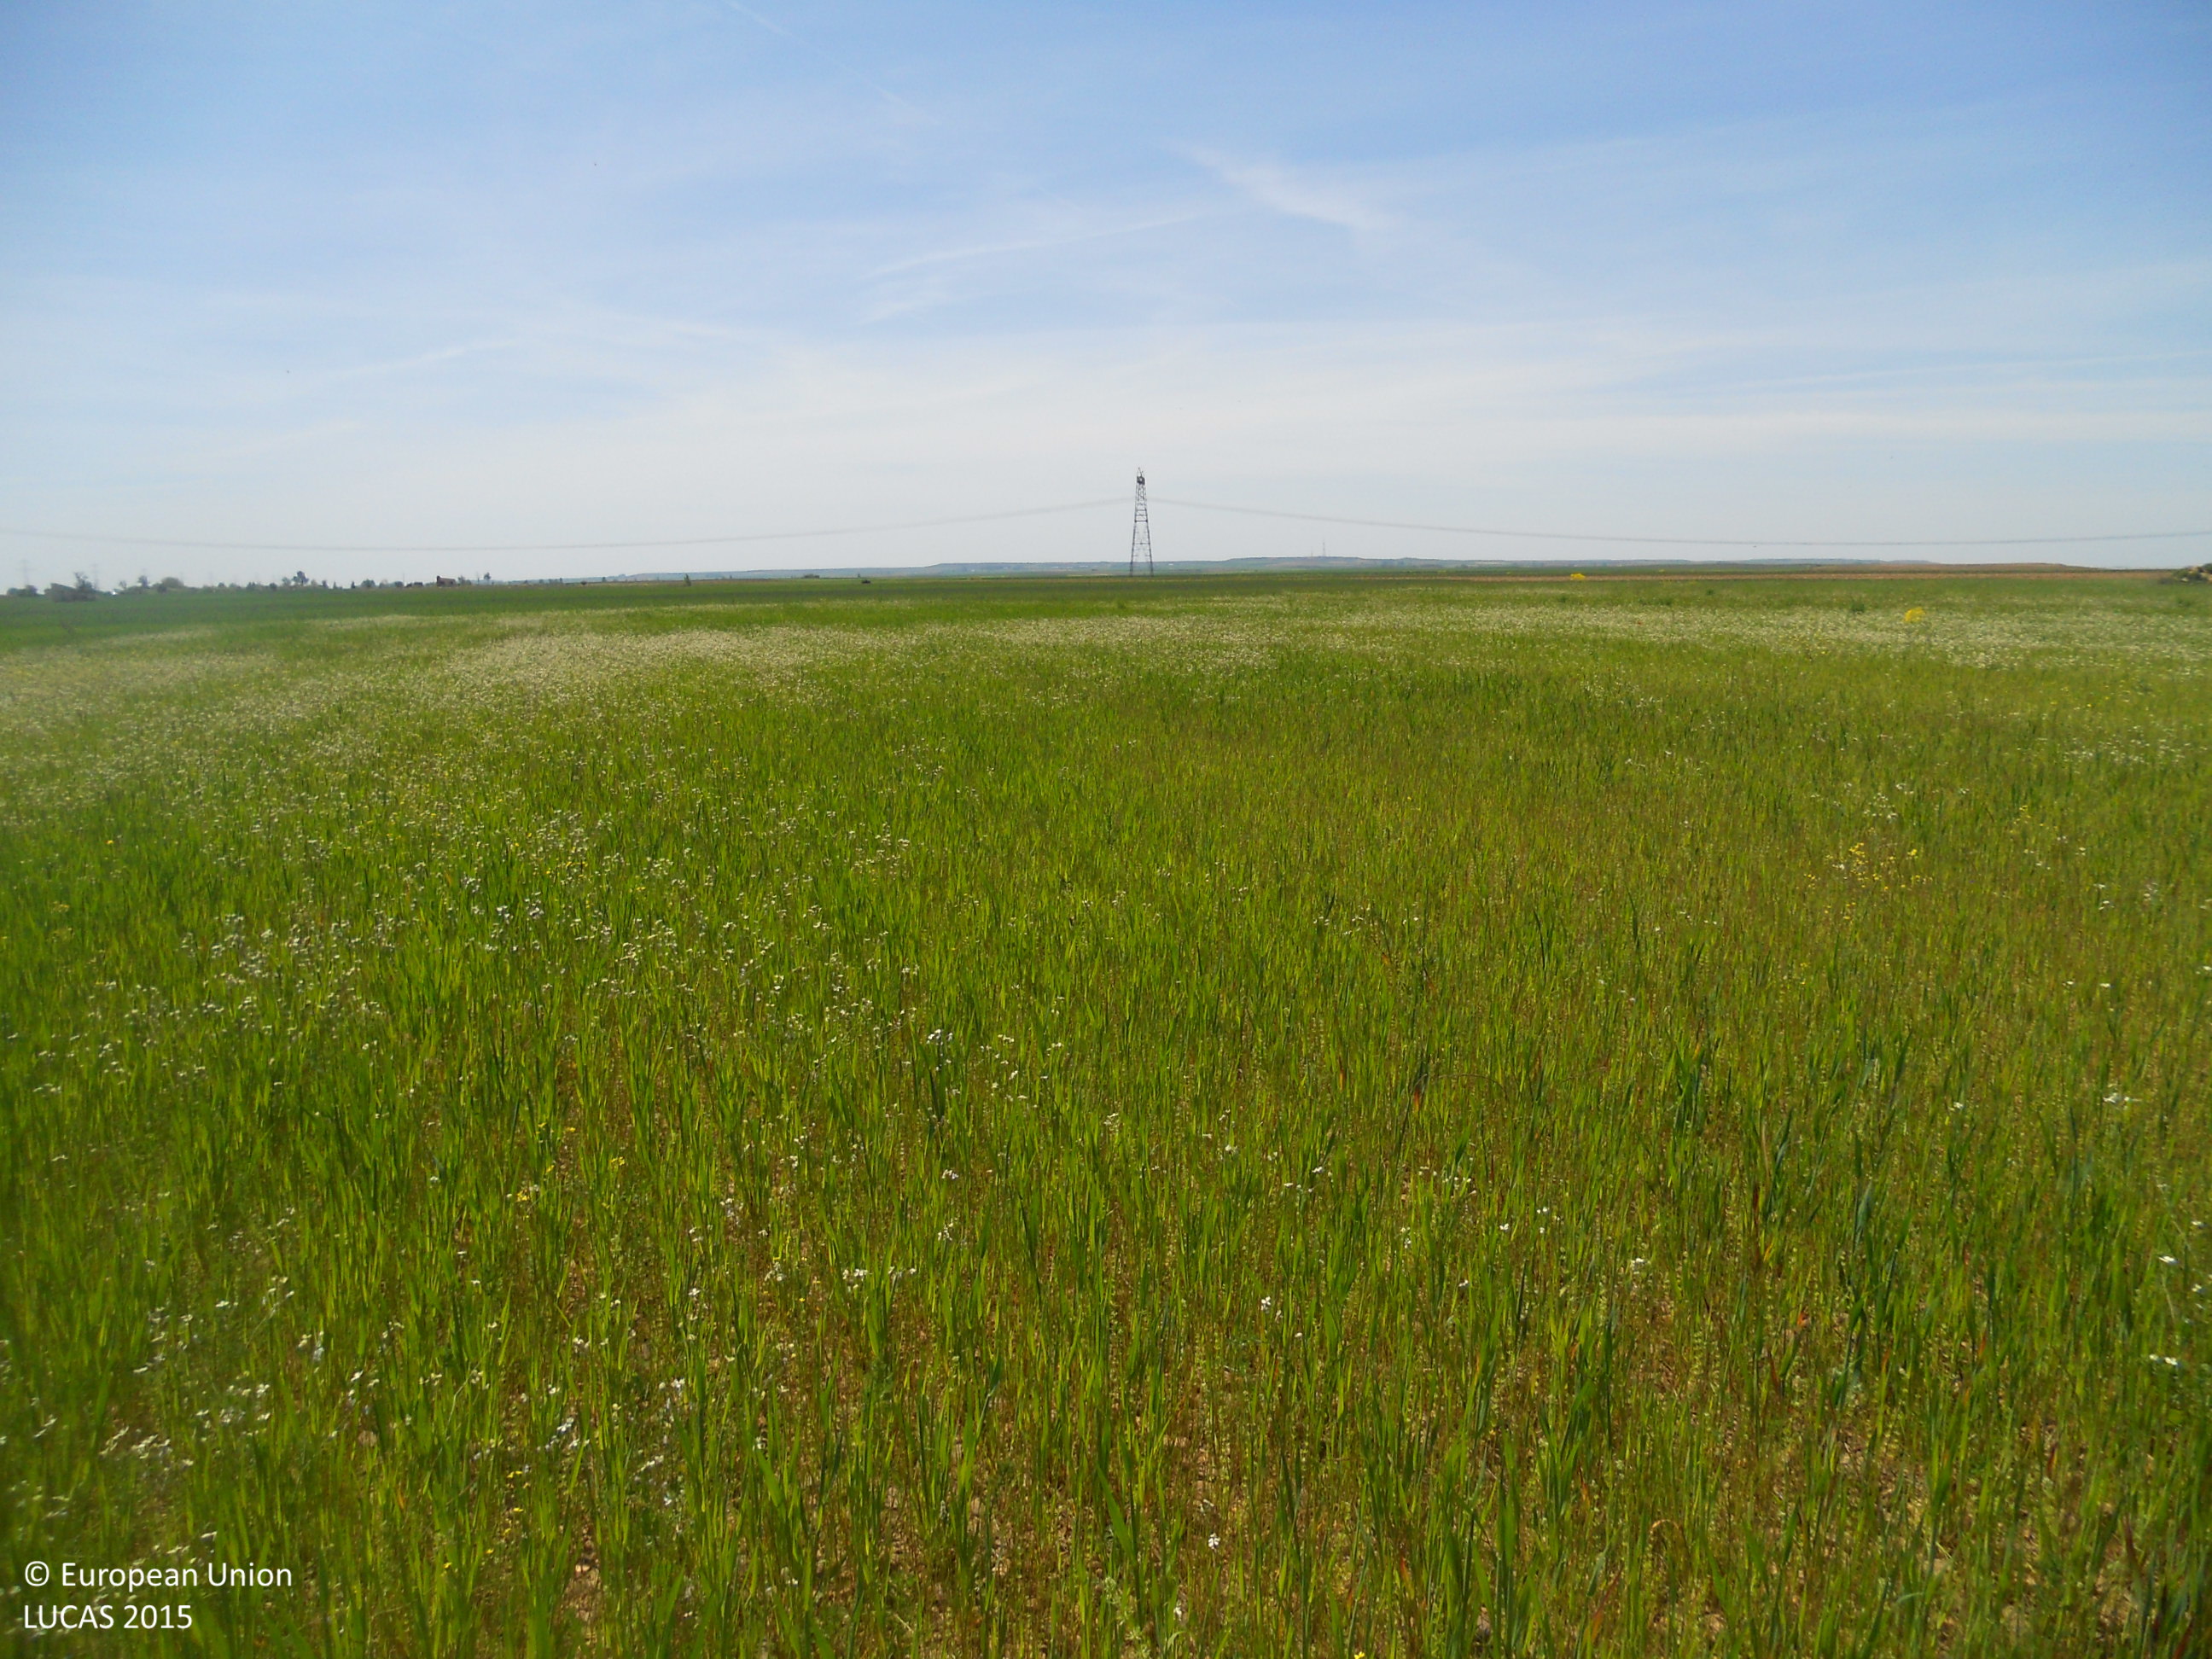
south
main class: Cropland
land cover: Oats
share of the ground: > 75 %
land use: Agriculture (excluding fallow land and kitchen gardens)
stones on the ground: 10 - 25 %
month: May
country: ES
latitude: 42.4271
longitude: -5.3690
